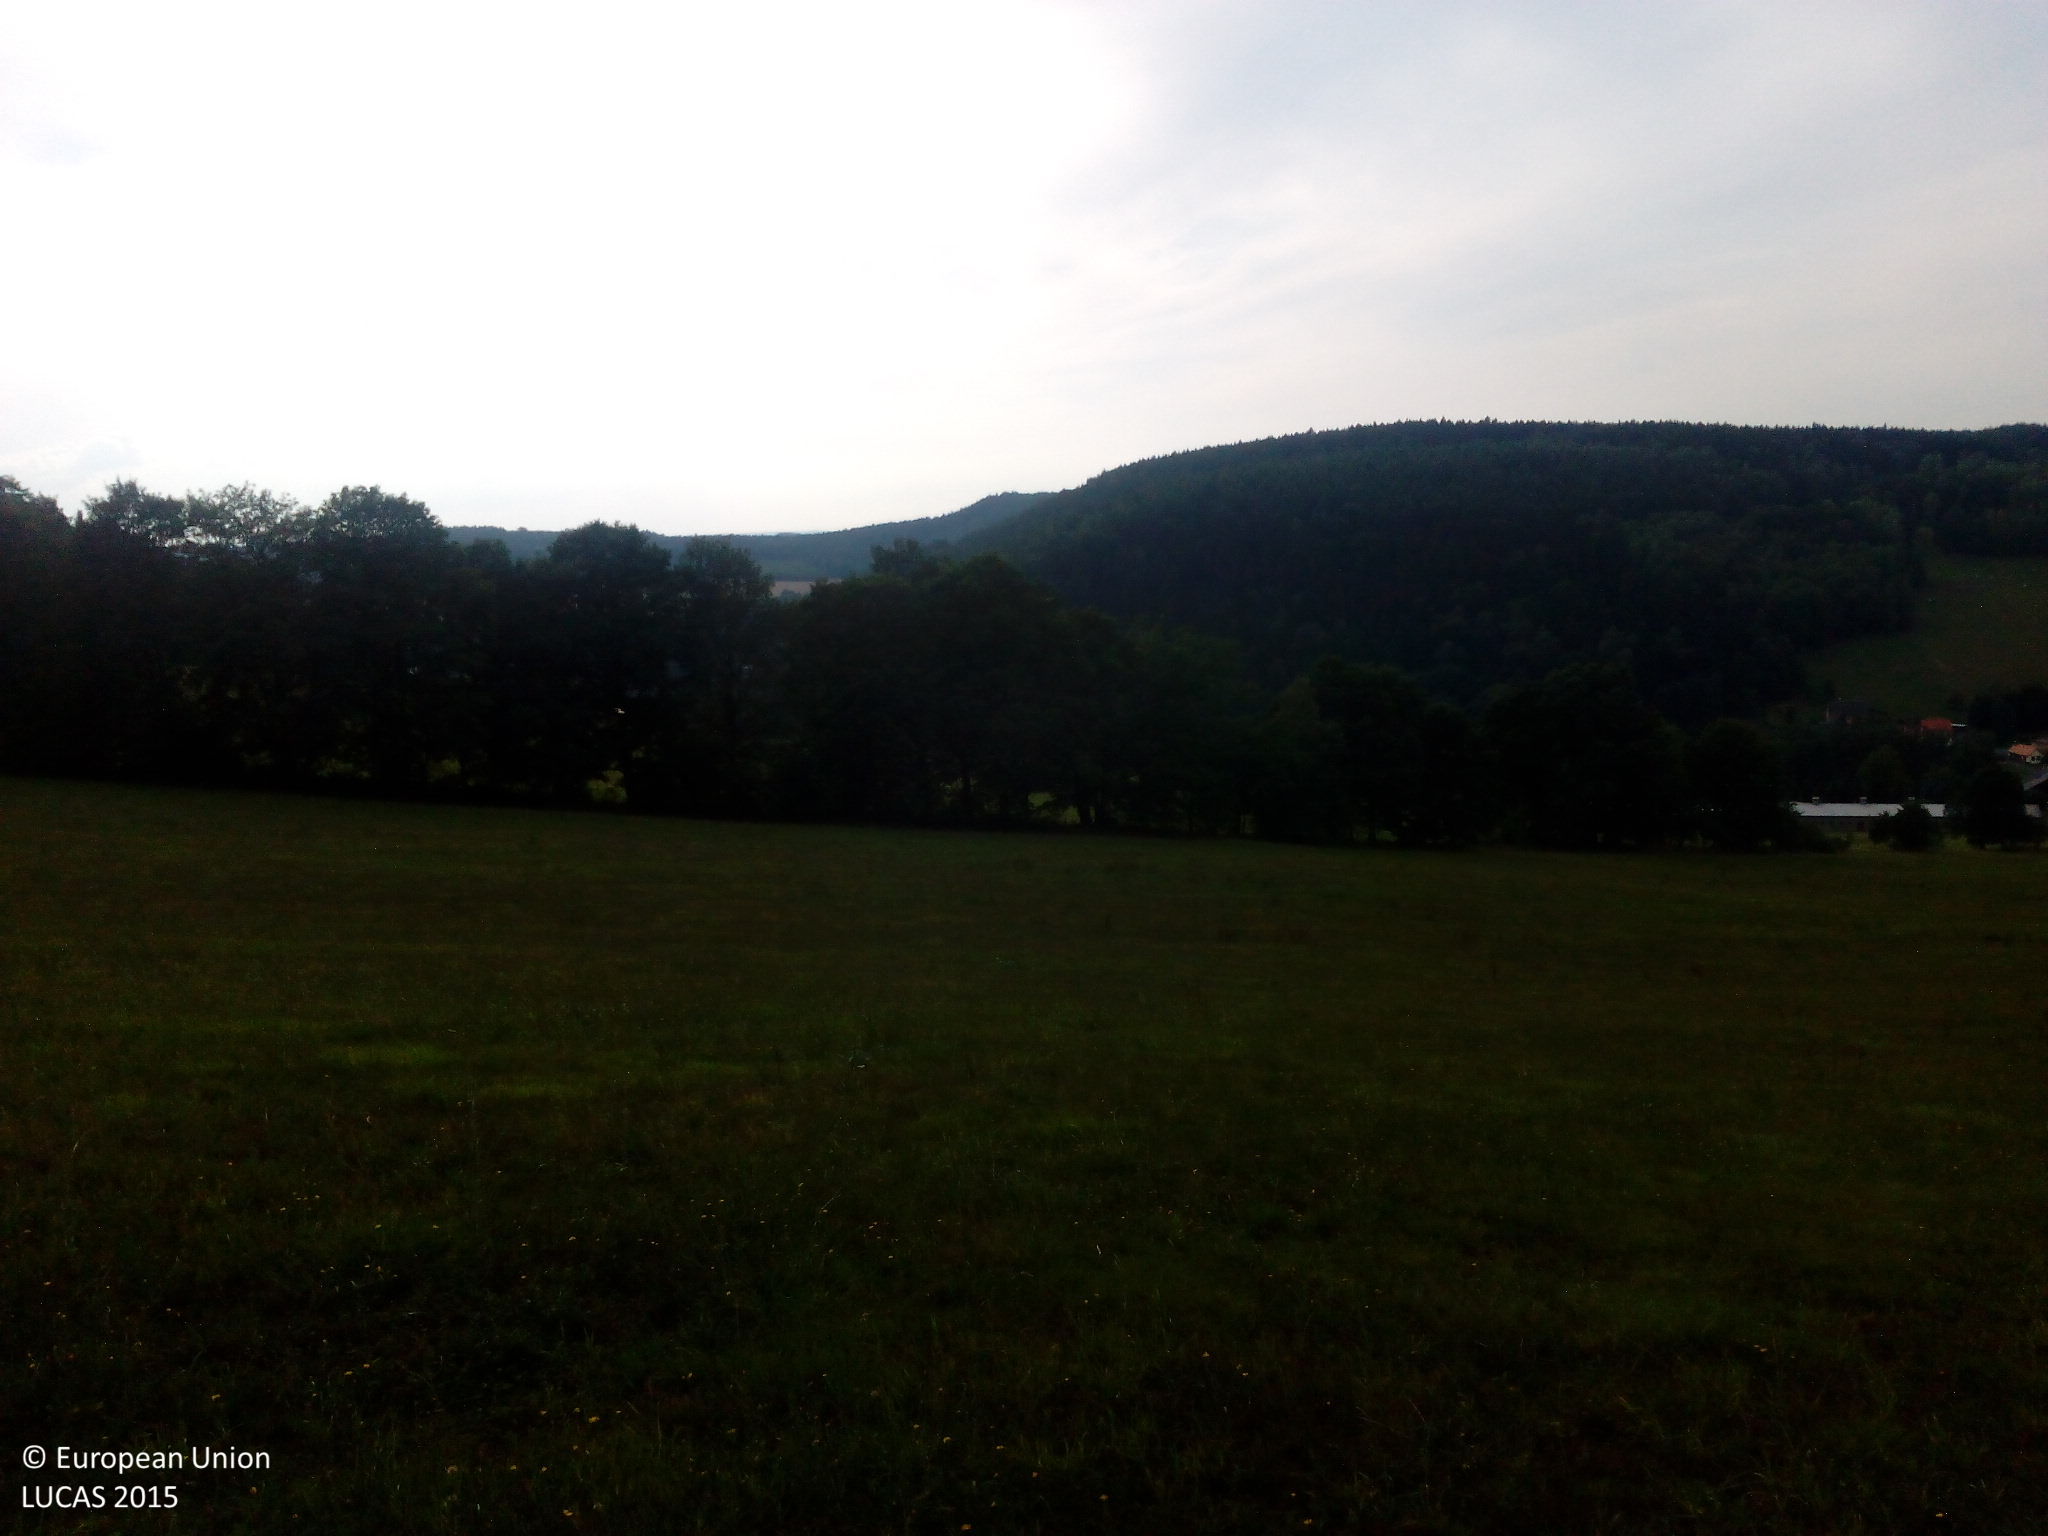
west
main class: Grassland
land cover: Grassland without tree/shrub cover
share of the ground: > 75 %
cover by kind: herbaceous plants 100 %
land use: Agriculture (excluding fallow land and kitchen gardens)
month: August
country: DE
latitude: 50.8345
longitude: 13.9910
